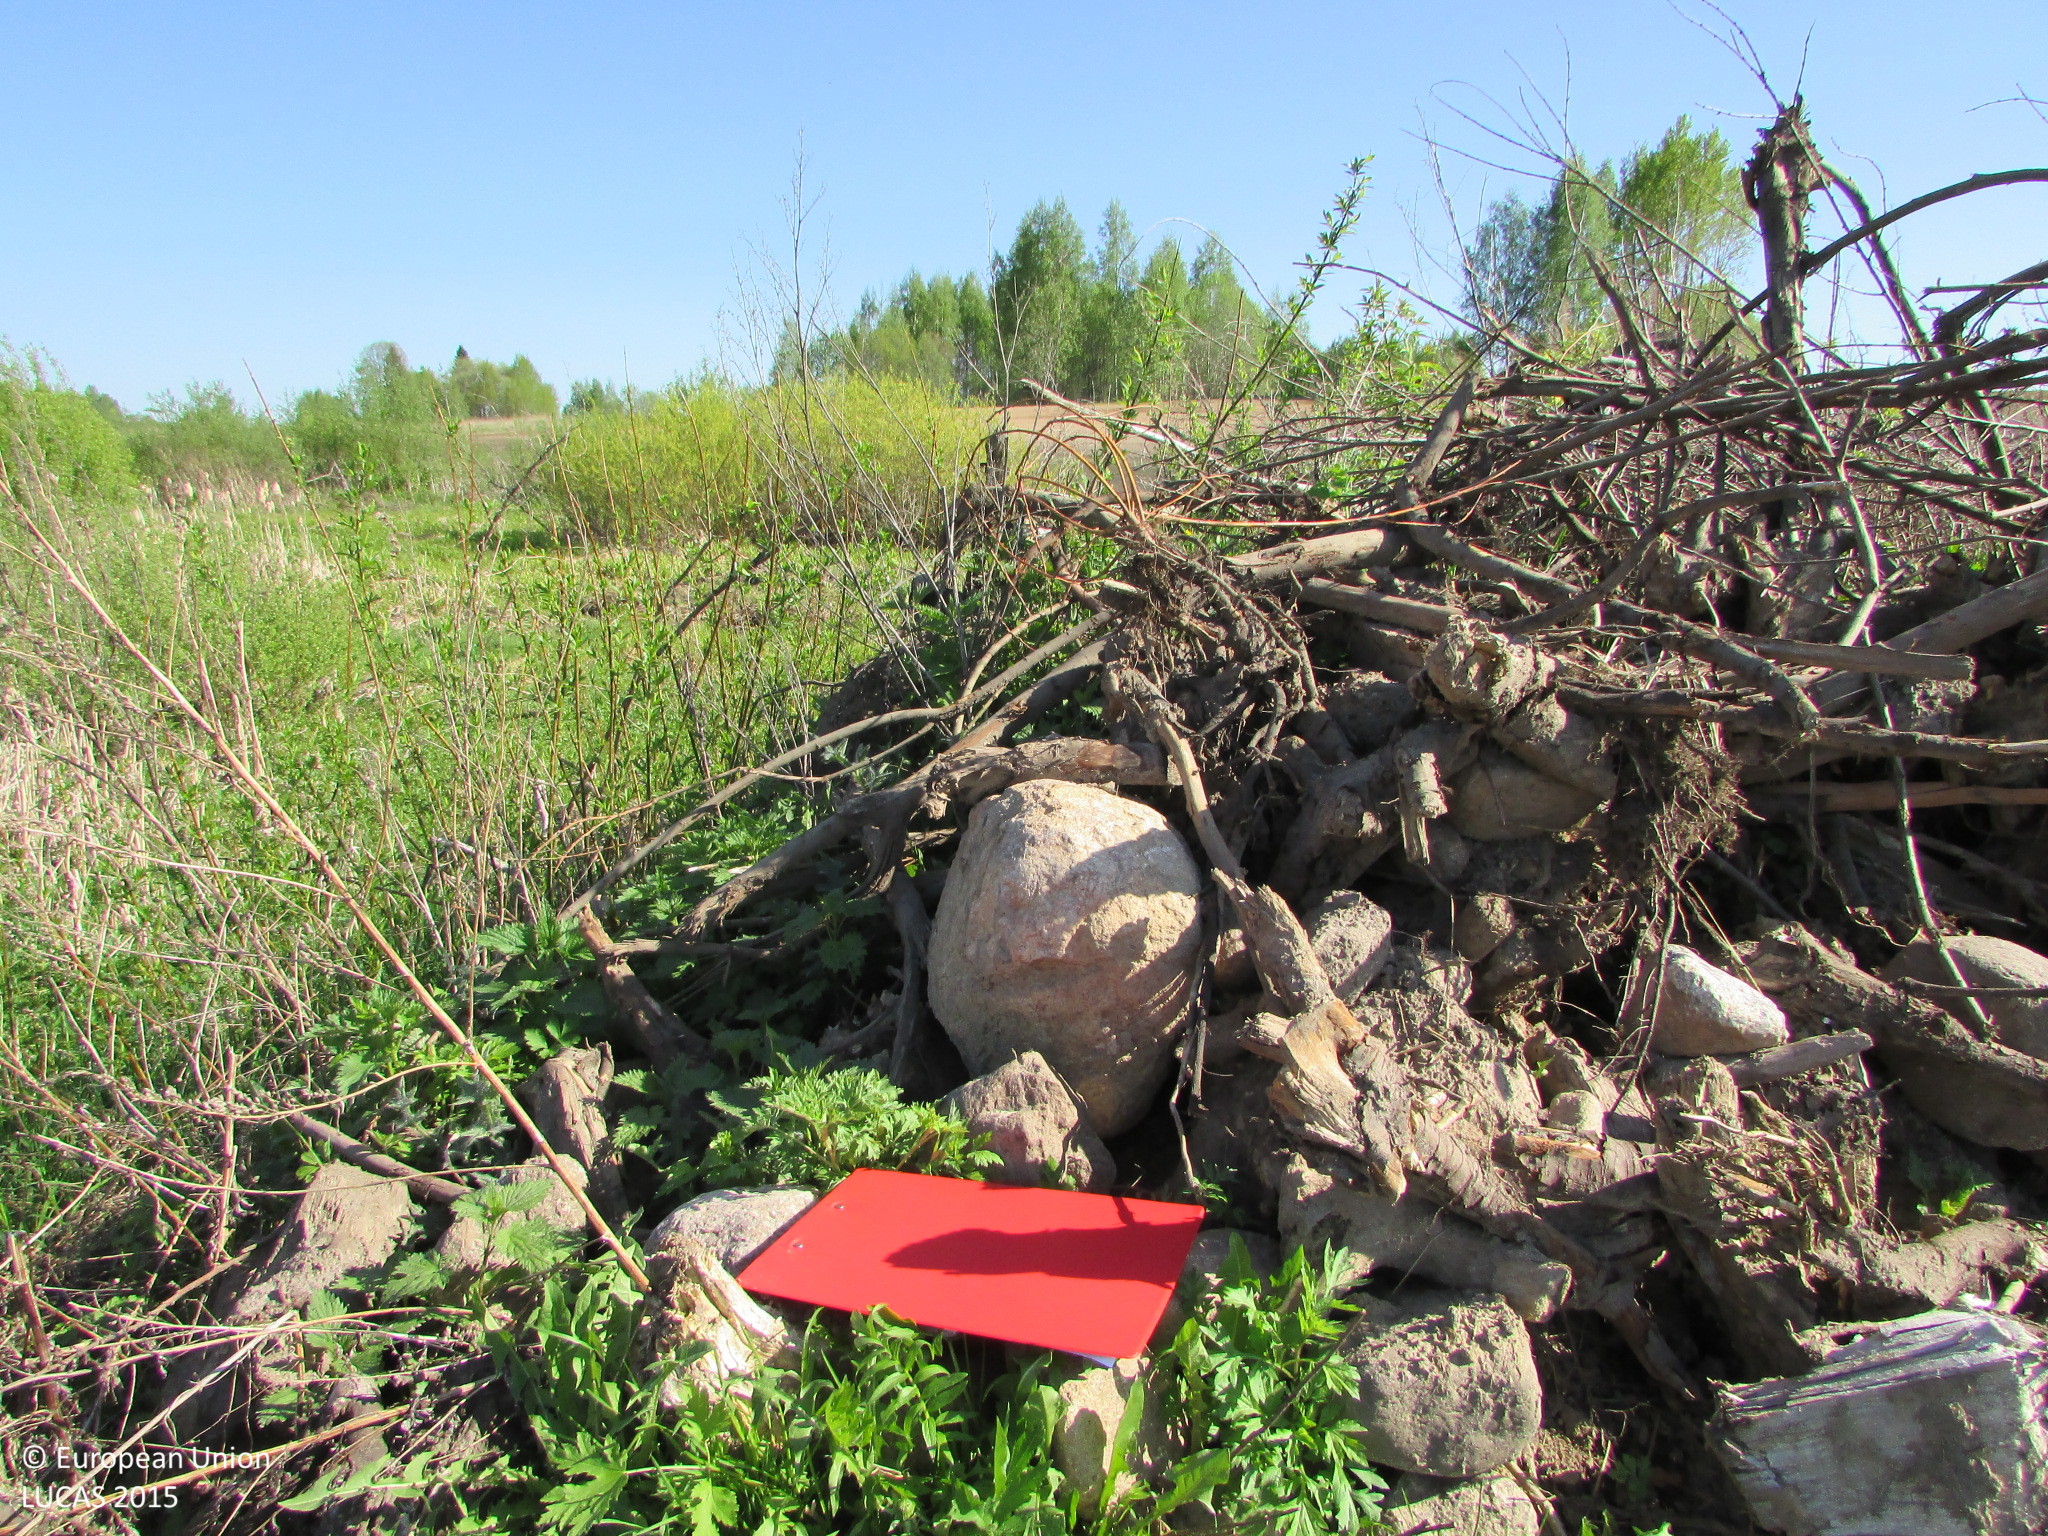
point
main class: Grassland
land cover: Spontaneously vegetated surfaces
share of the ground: 50 - 75 %
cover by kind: herbaceous plants 60 %, shrubs 5 %
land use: Semi-natural and natural areas not in use
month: May
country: LV
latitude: 55.8541
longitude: 27.5151
